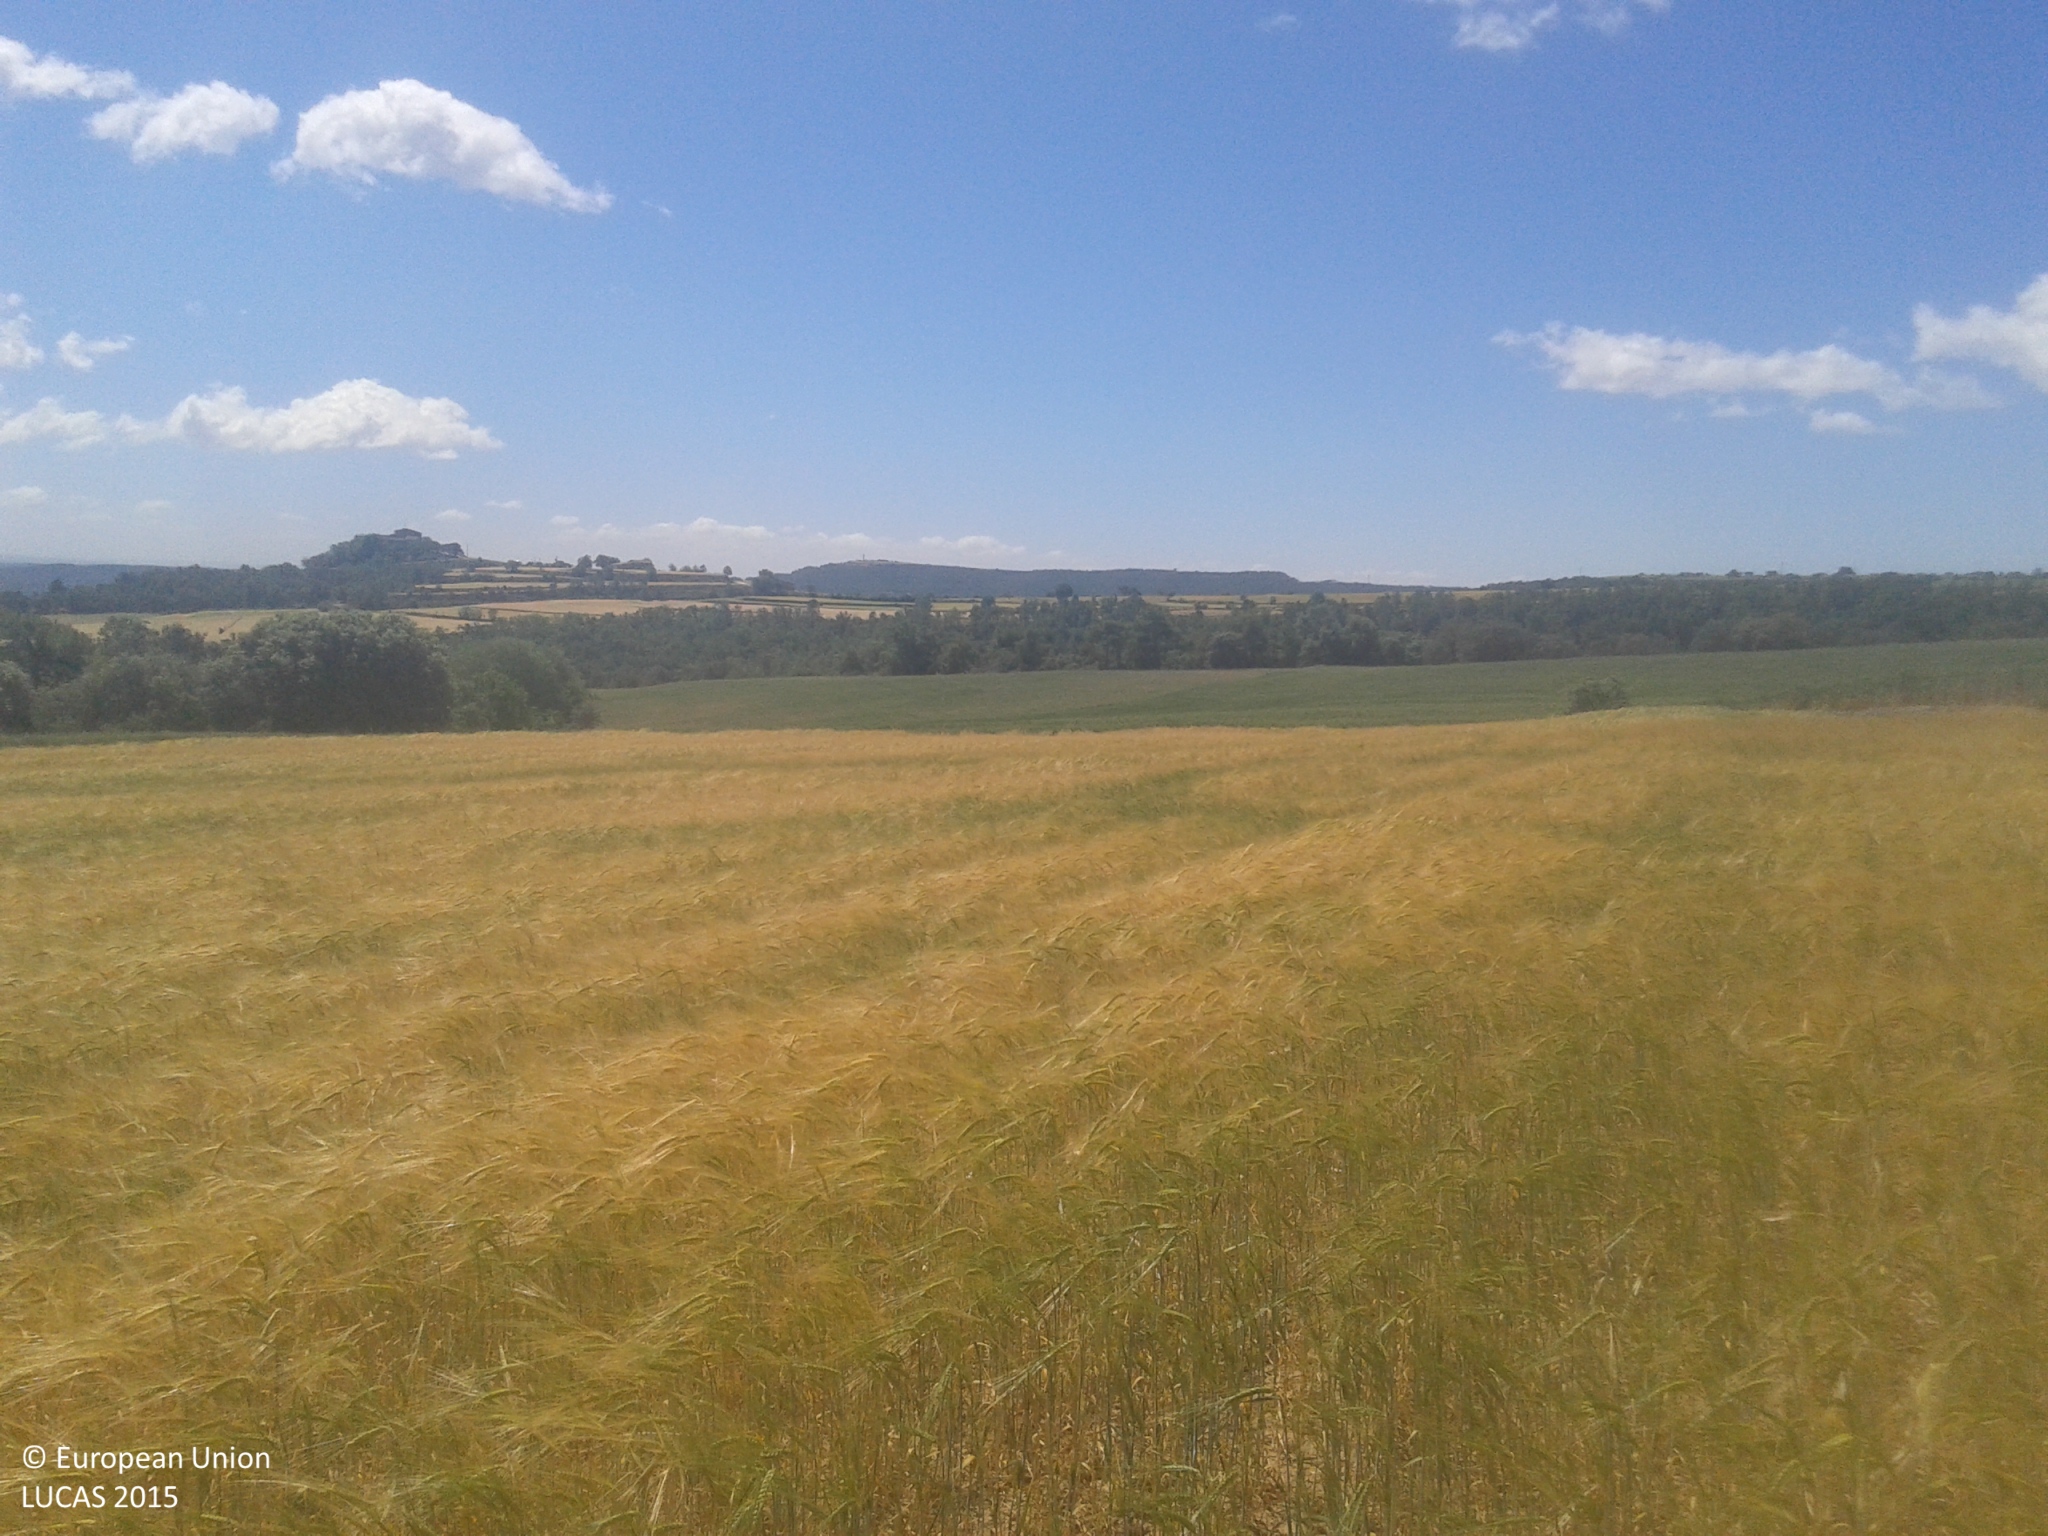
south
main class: Cropland
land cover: Barley
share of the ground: > 75 %
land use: Agriculture (excluding fallow land and kitchen gardens)
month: May
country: ES
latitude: 41.9567
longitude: 1.1440
